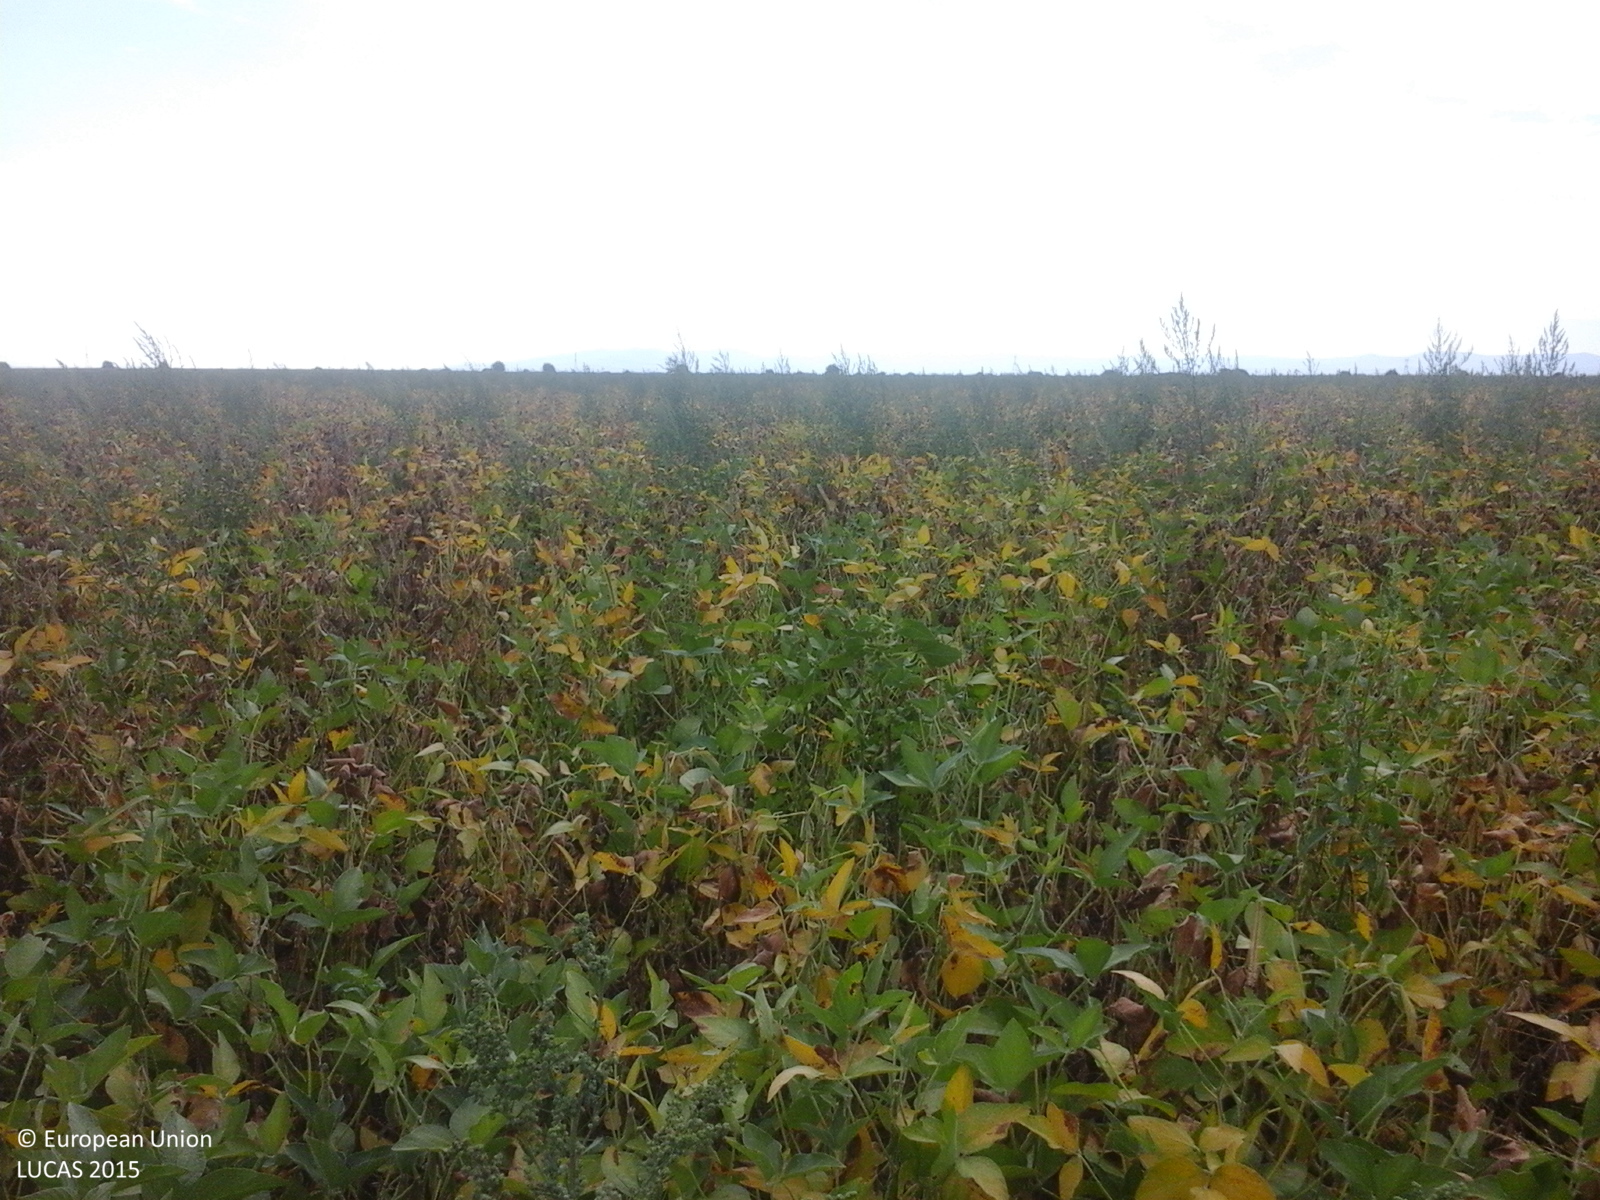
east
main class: Cropland
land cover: Soya
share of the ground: > 75 %
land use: Agriculture (excluding fallow land and kitchen gardens)
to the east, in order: Soya
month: August
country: RO
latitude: 46.3009
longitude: 21.4218
